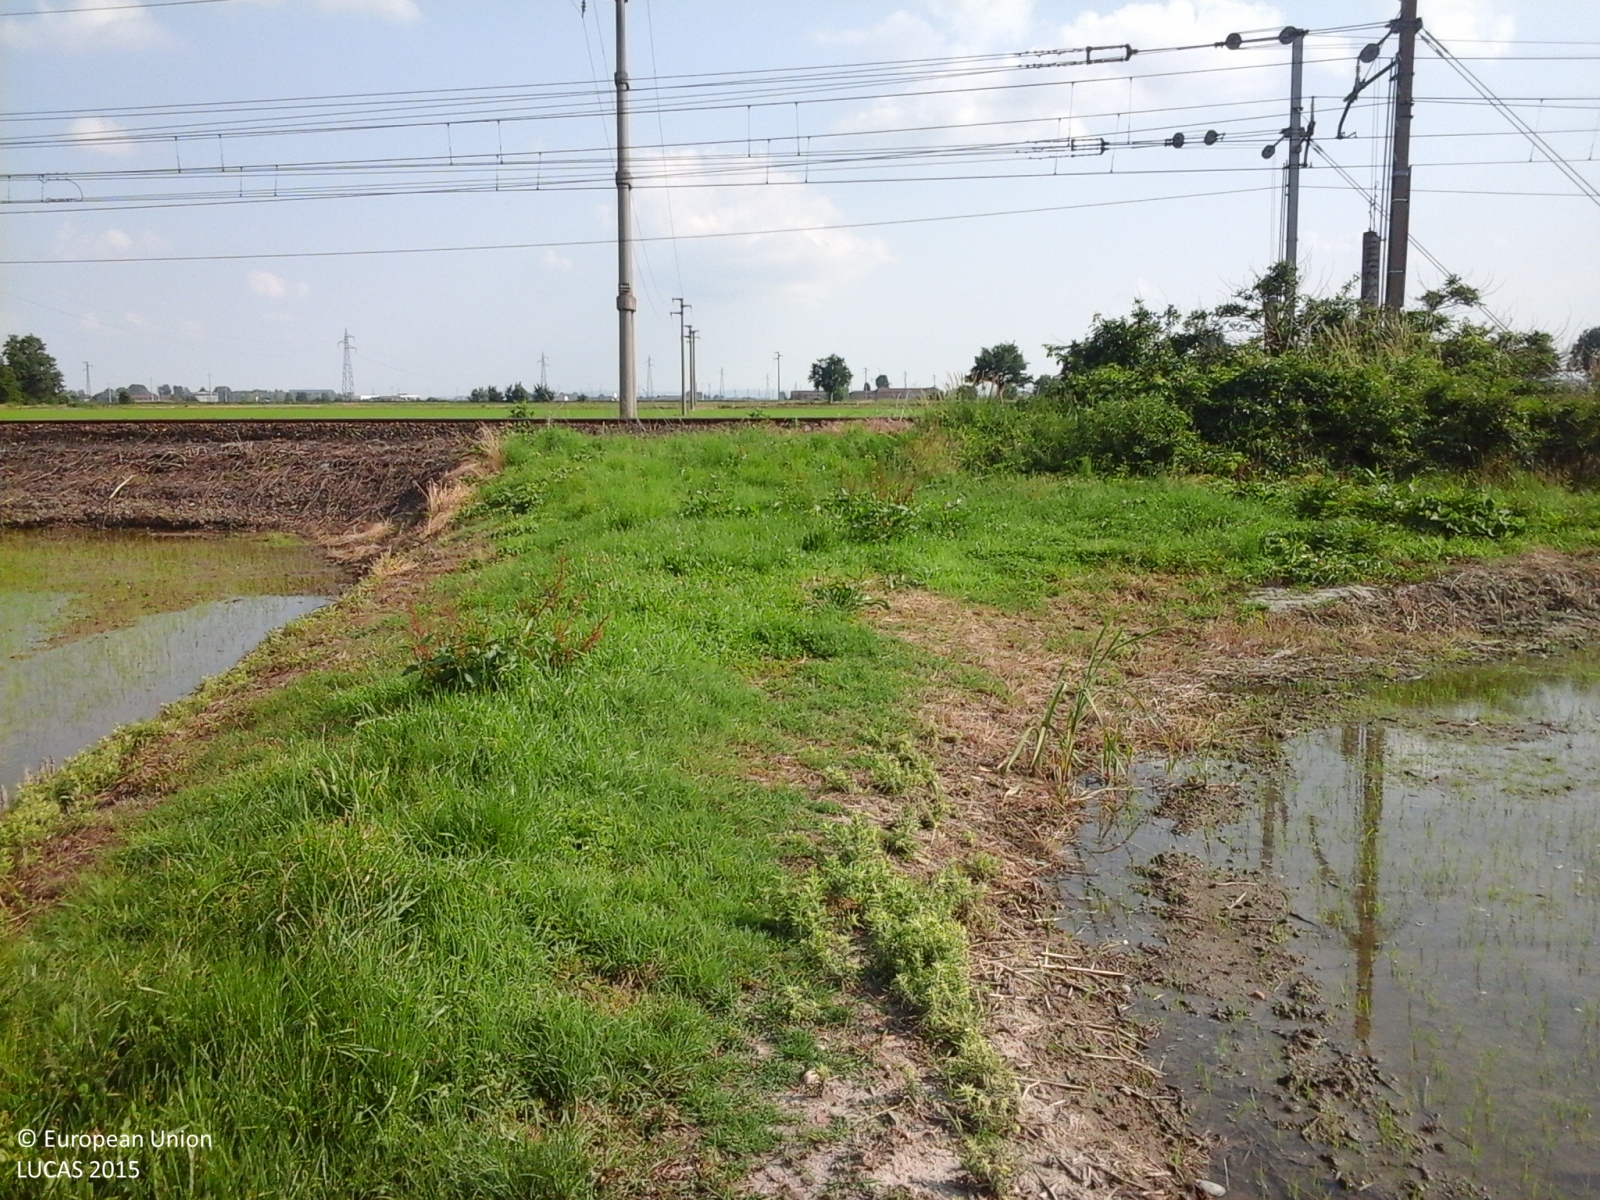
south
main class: Cropland
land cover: Rice
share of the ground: 25 - 50 %
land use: Agriculture (excluding fallow land and kitchen gardens)
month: May
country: IT
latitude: 45.3298
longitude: 8.3824
